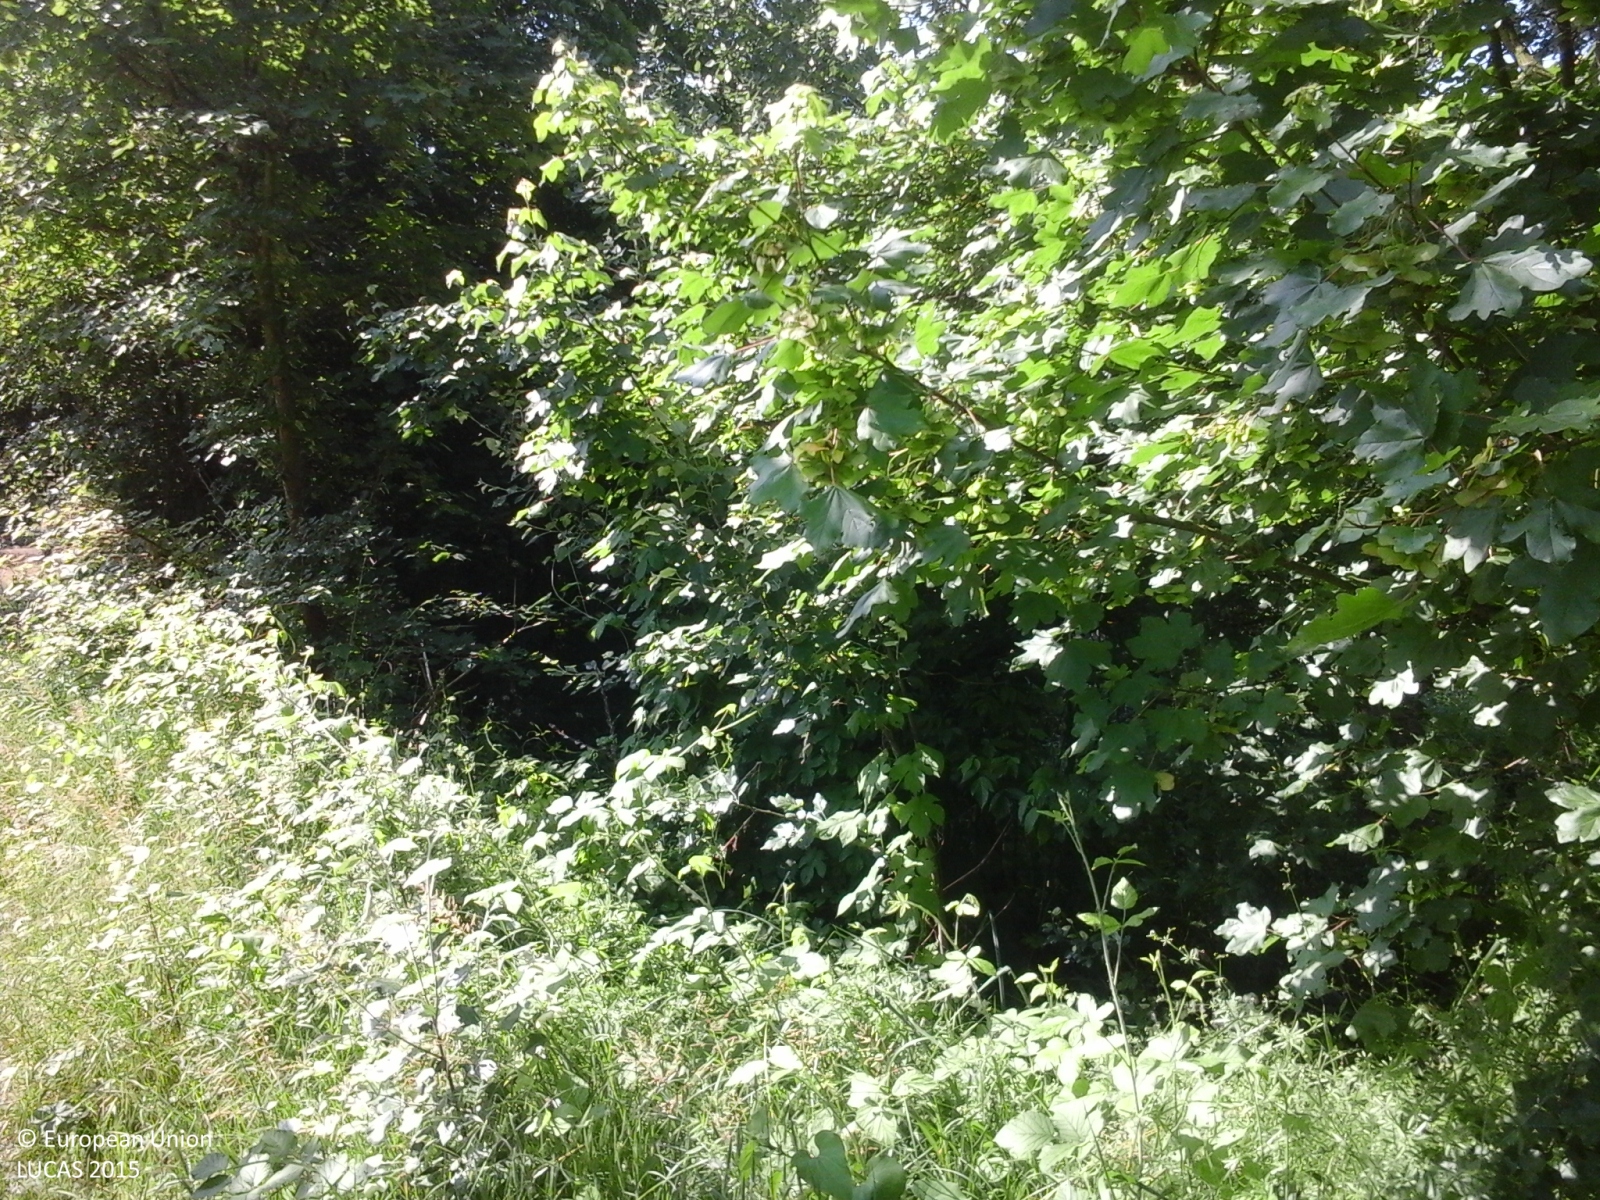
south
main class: Shrubland
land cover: Shrubland with sparse tree cover
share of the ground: > 75 %
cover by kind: shrubs 70 %, herbaceous plants 25 %, broadleaved forest trees 5 %
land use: Semi-natural and natural areas not in use
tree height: > 5 m
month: May
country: IT
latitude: 45.2308
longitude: 9.1736
